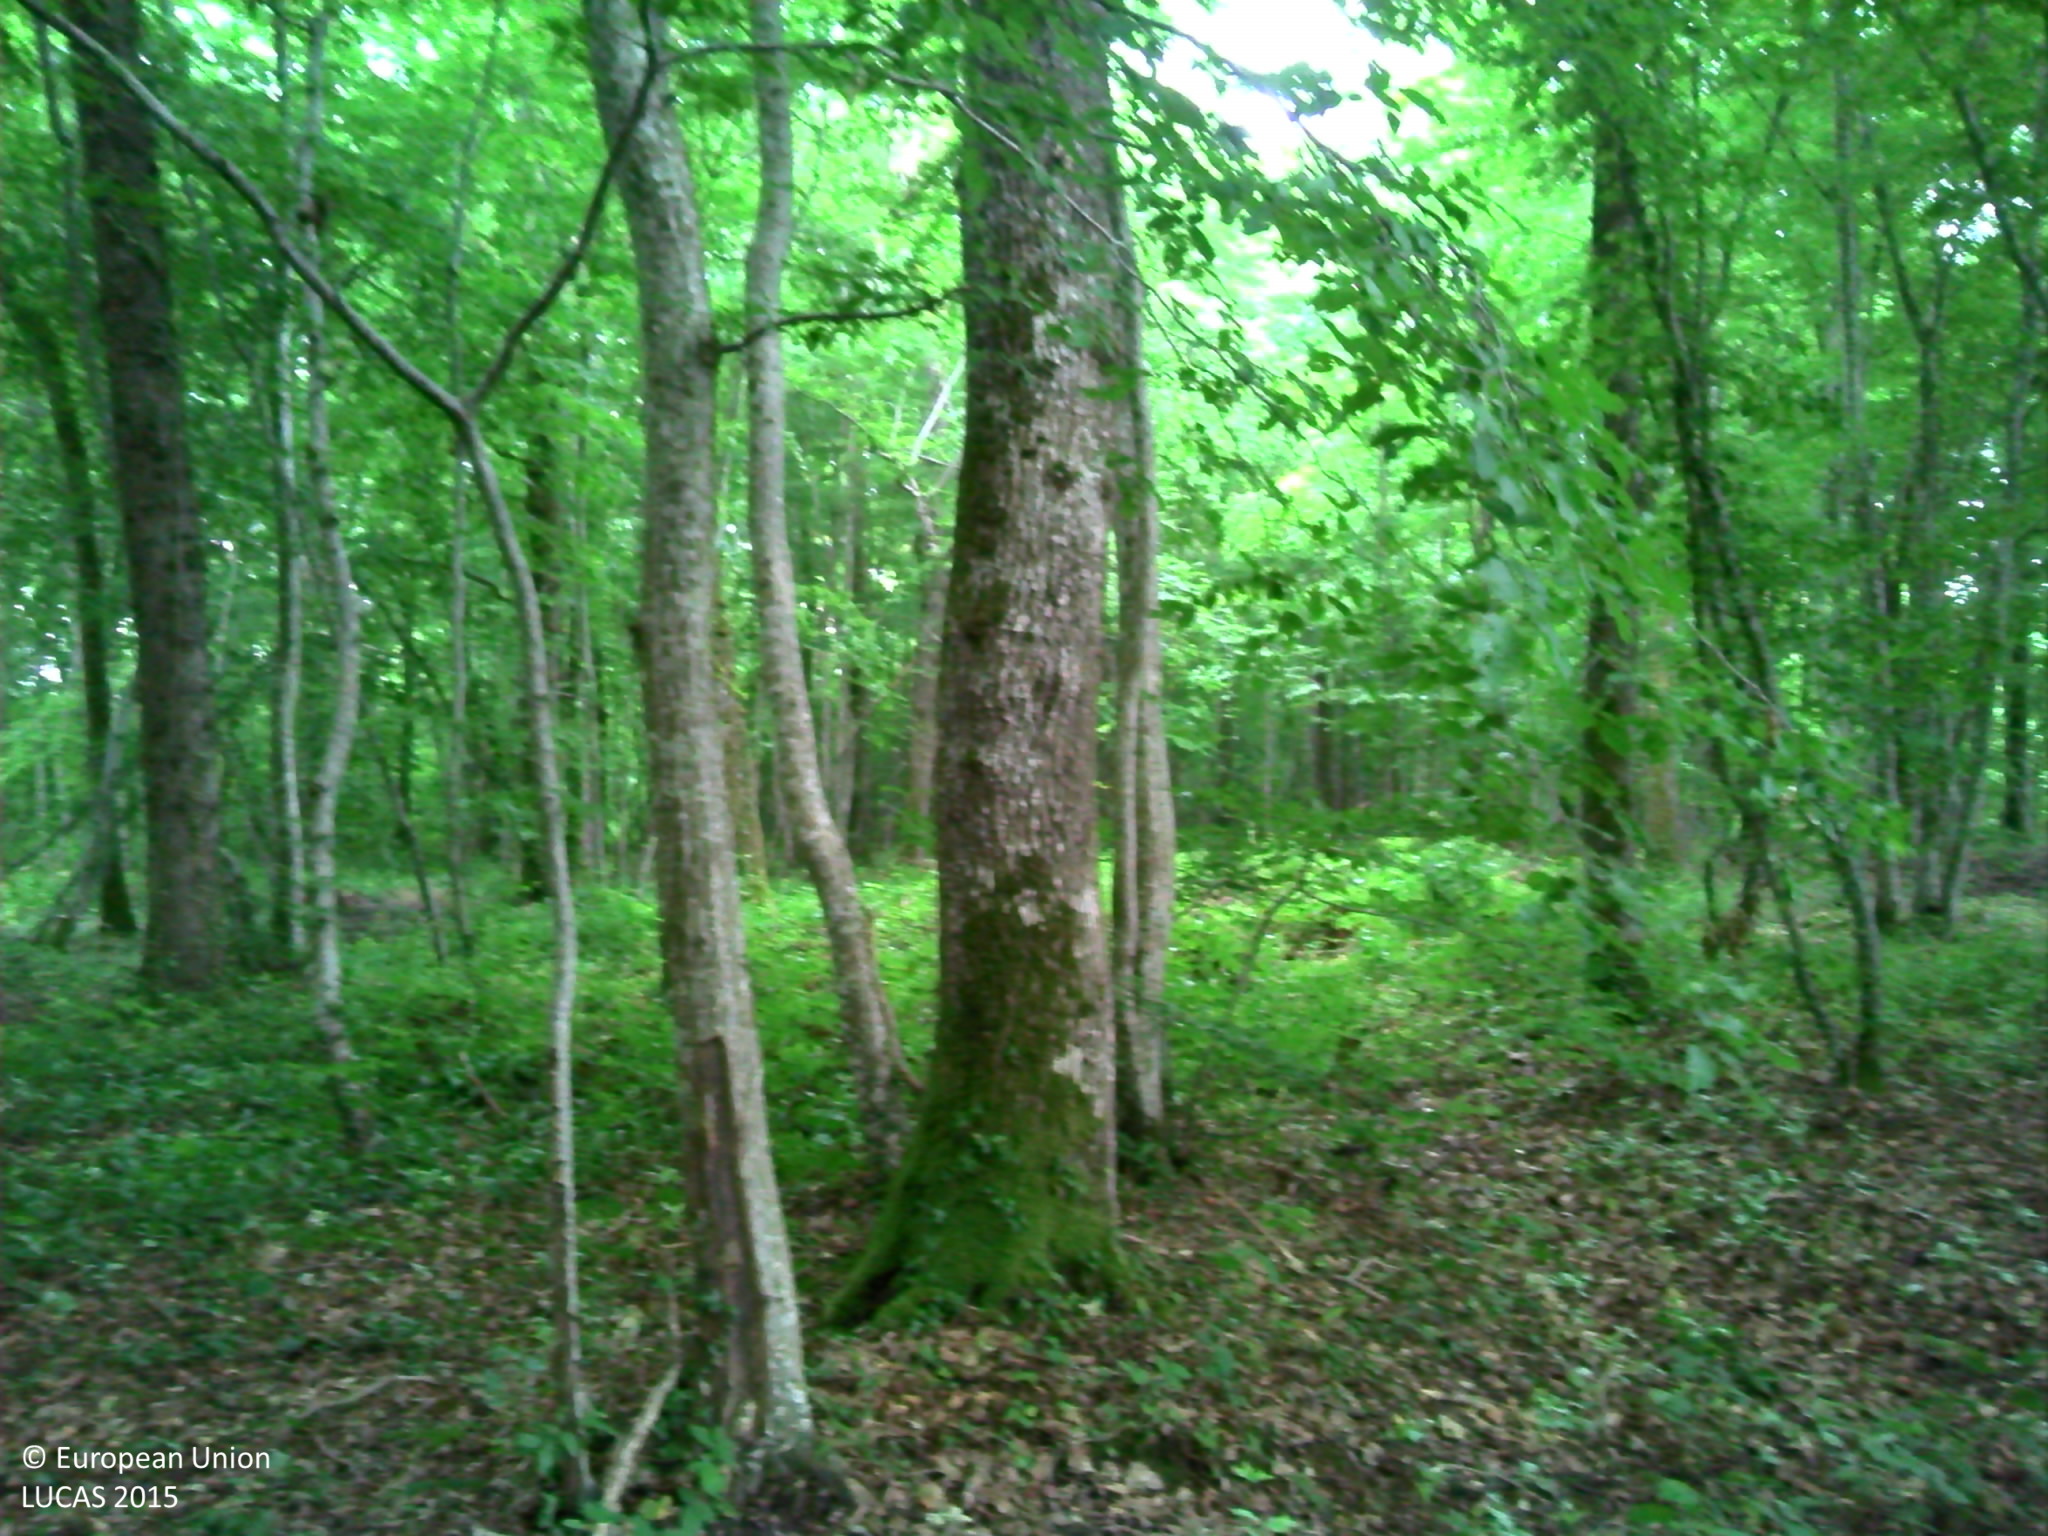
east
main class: Woodland
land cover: Broadleaved woodland
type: mesophytic deciduous forest
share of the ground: > 75 %
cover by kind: broadleaved forest trees 90 %, shrubs 5 %, herbaceous plants 5 %
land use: Forestry
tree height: > 5 m
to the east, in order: Broadleaved woodland; Tracks; Broadleaved woodland; Ditches and canals; Spontaneously vegetated surfaces
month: June
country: FR
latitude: 46.3076
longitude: 3.0772
